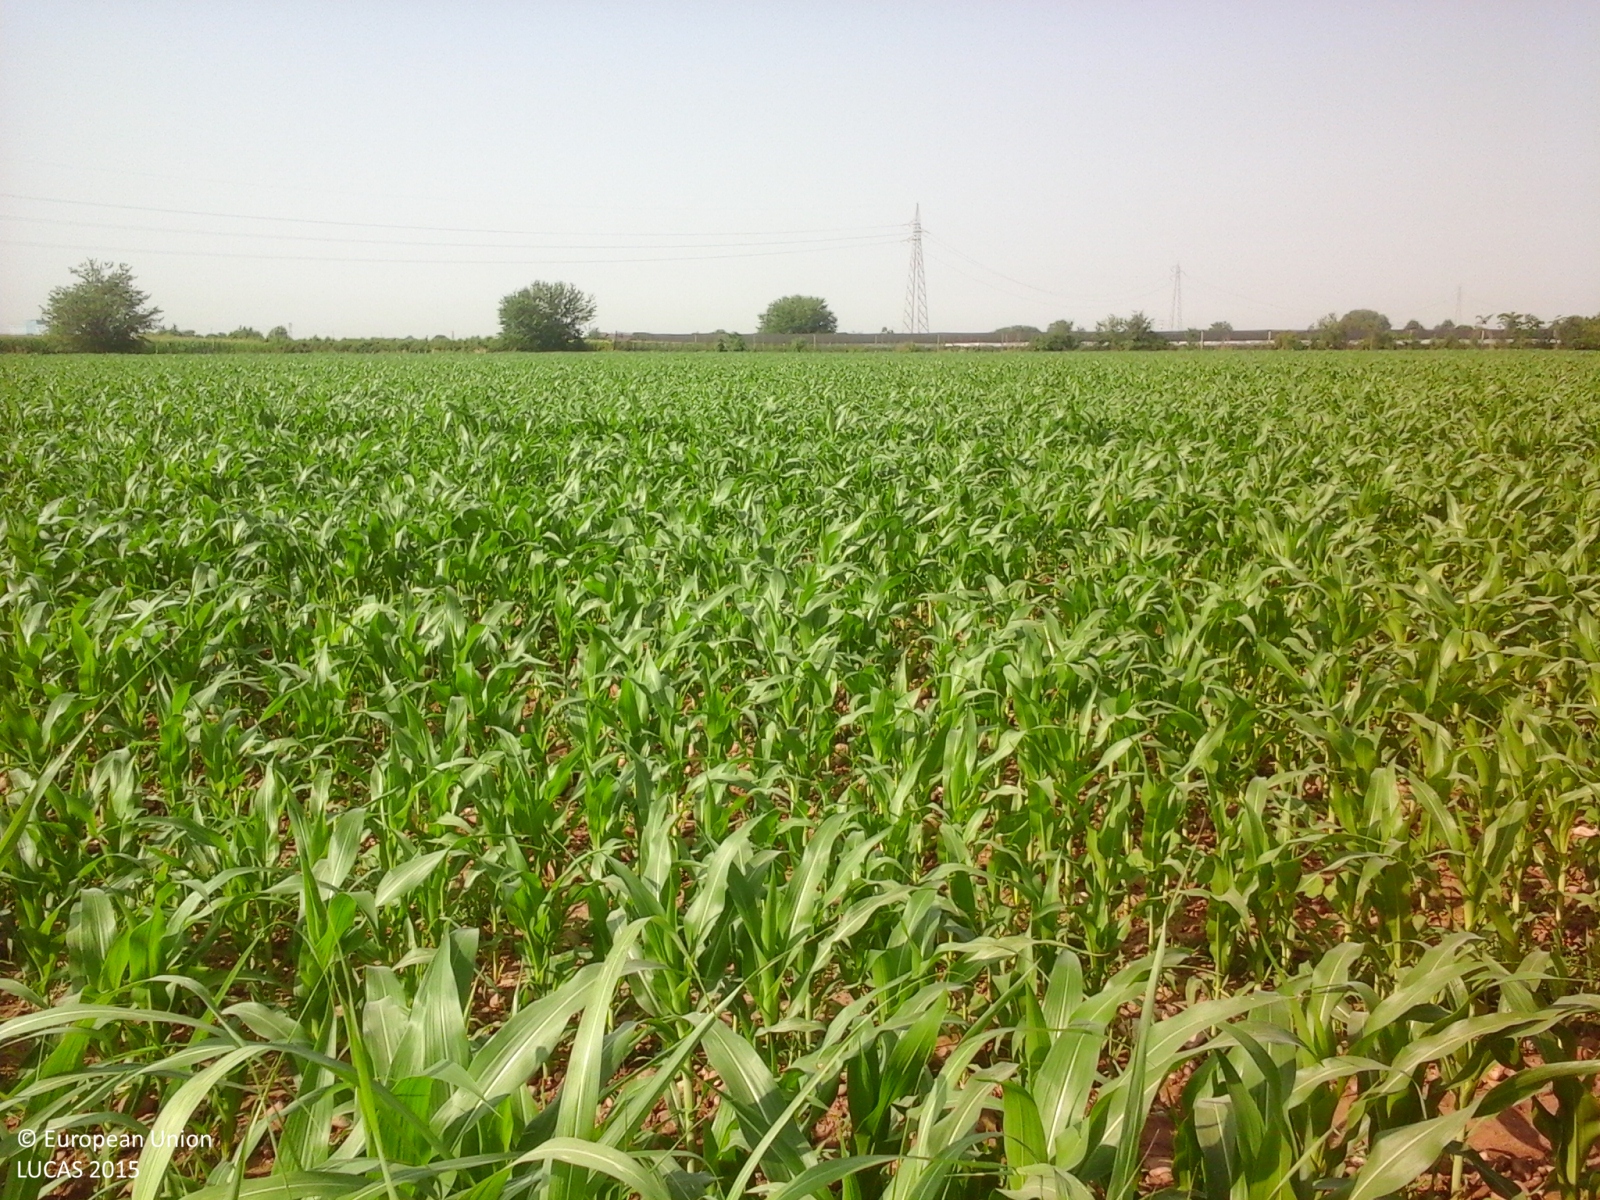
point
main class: Cropland
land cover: Maize
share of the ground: 50 - 75 %
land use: Agriculture (excluding fallow land and kitchen gardens)
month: July
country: IT
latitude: 45.3389
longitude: 10.8280
